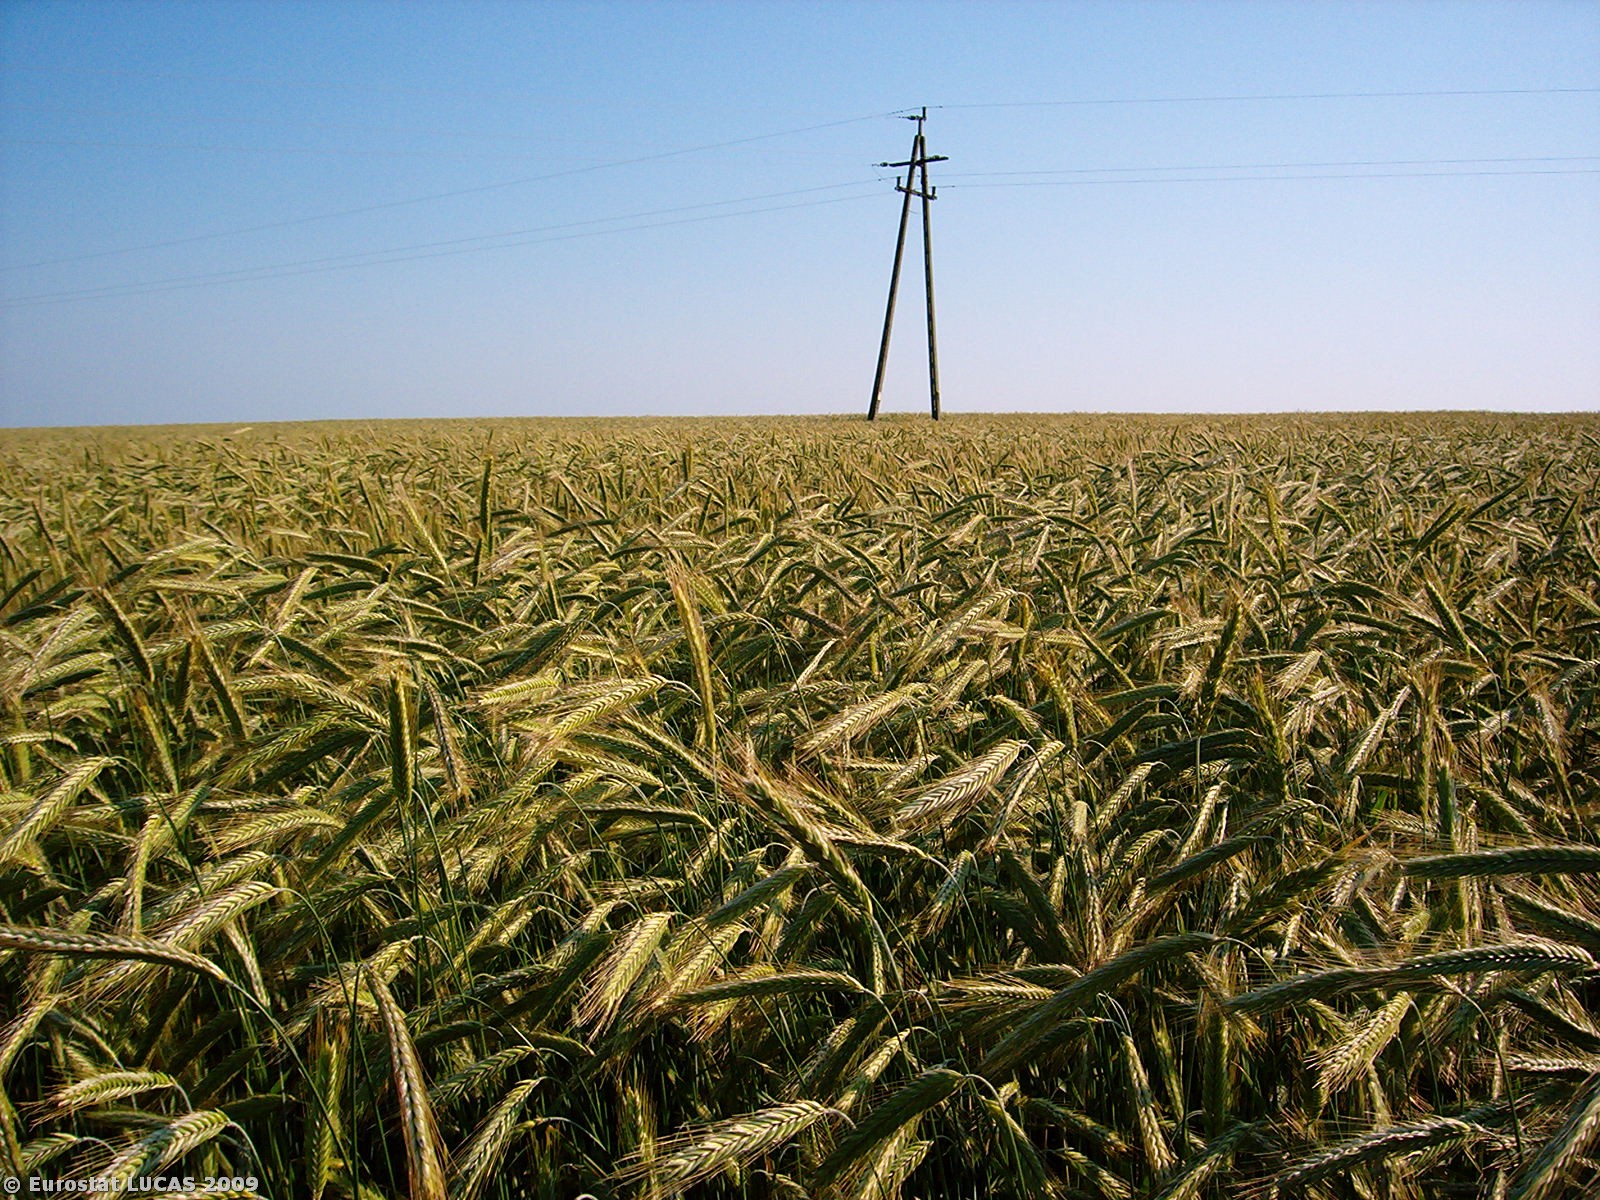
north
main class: Cropland
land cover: Triticale
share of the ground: > 75 %
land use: Agriculture (excluding fallow land and kitchen gardens)
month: June
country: PL
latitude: 53.6981
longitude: 15.3494
